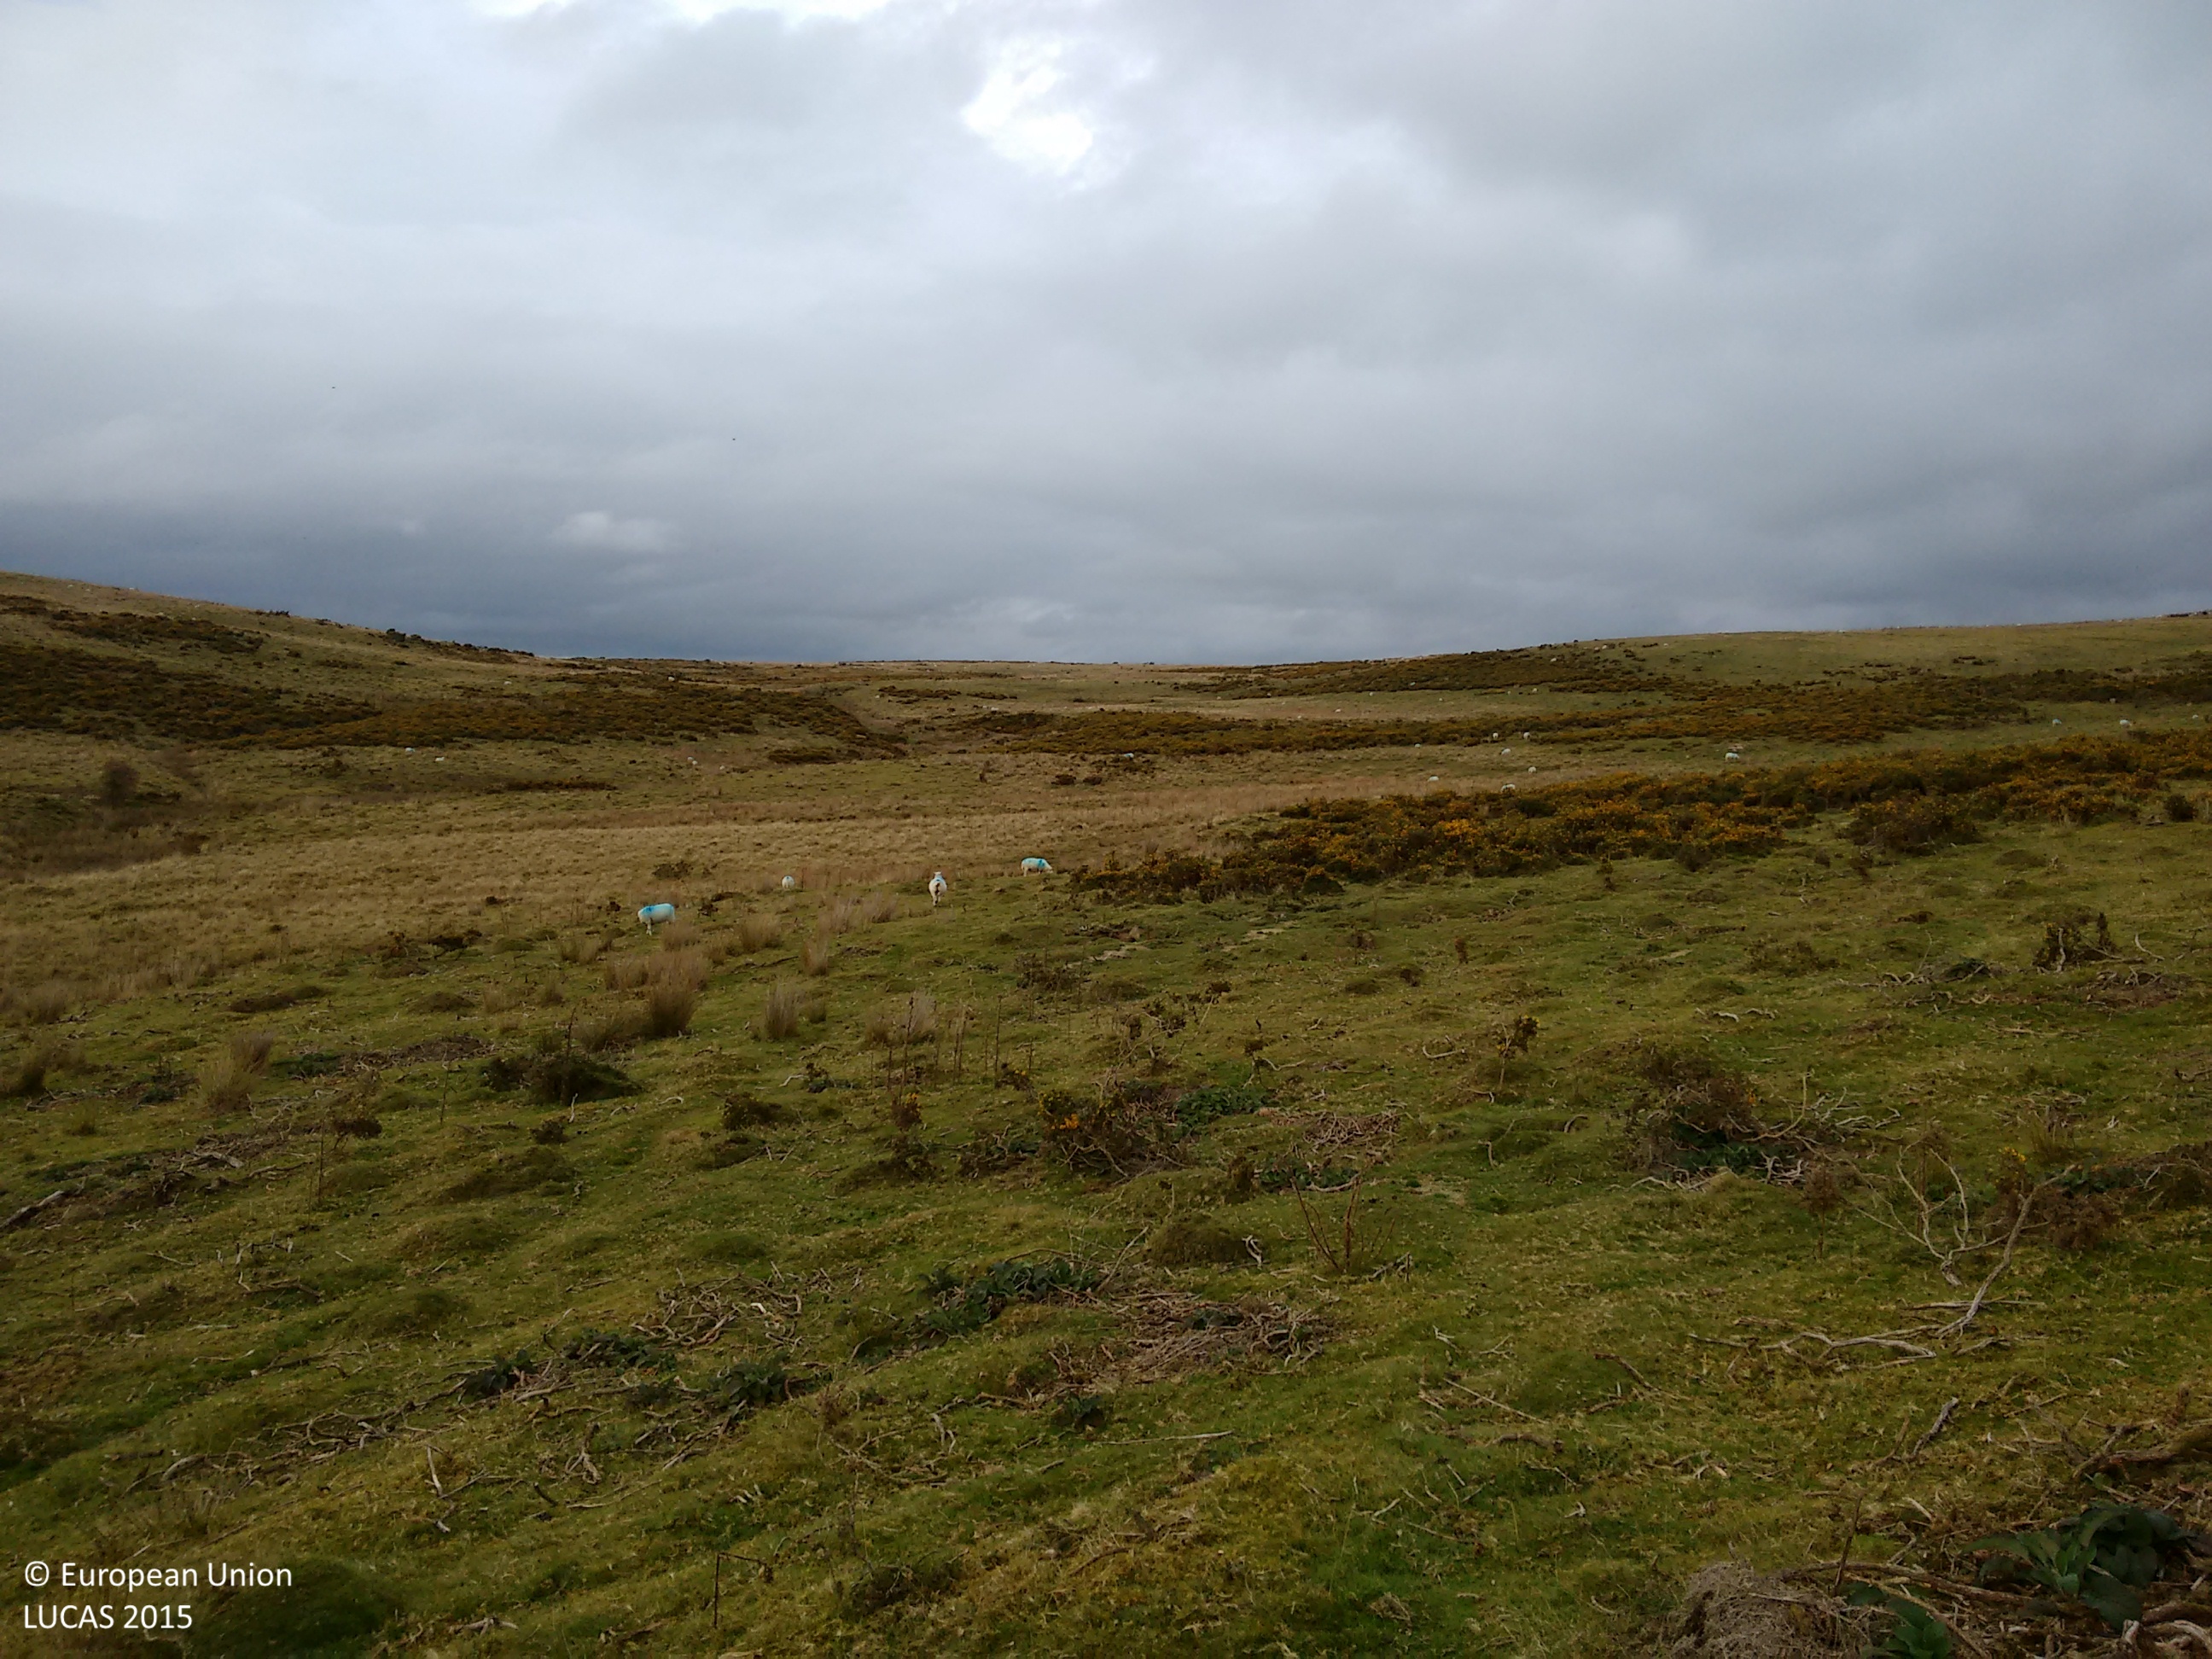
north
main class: Grassland
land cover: Grassland without tree/shrub cover
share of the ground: > 75 %
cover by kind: herbaceous plants 90 %, shrubs 5 %, lichens and mosses 5 %
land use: Agriculture (excluding fallow land and kitchen gardens)
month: October
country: GB
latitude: 52.2649
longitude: -3.2823
